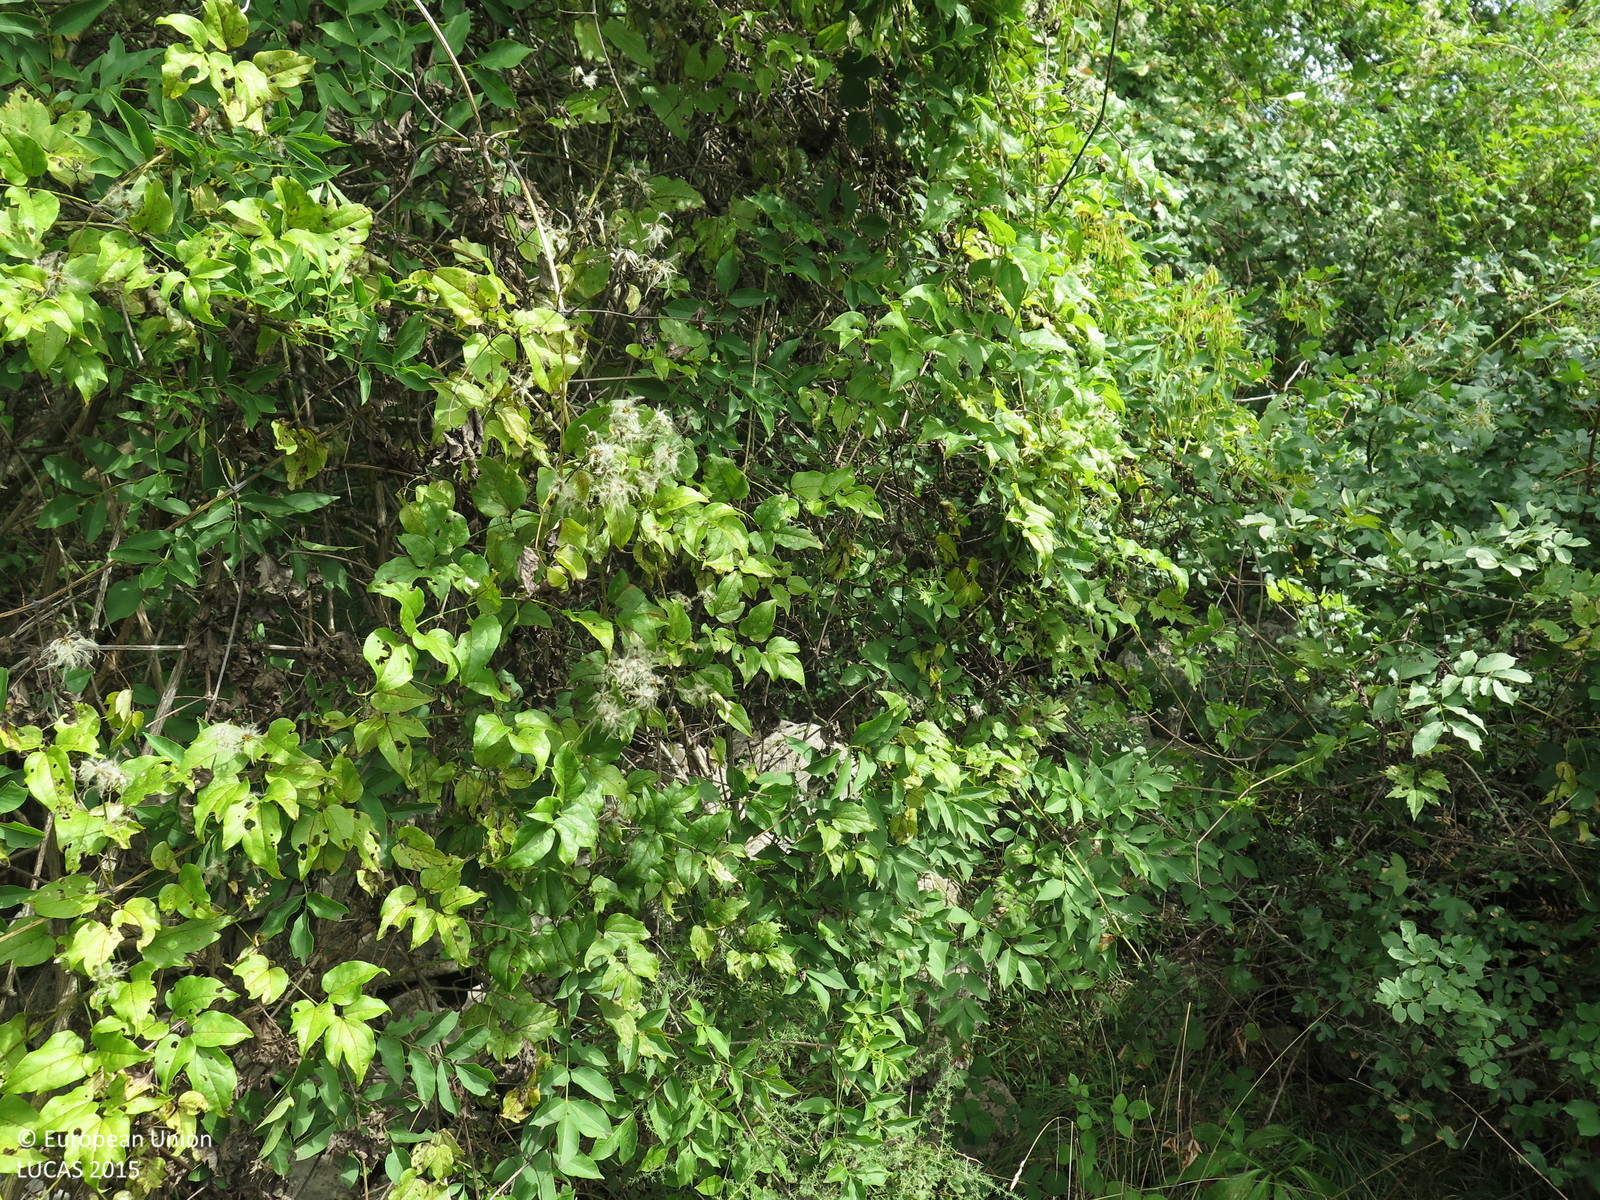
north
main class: Woodland
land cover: Broadleaved woodland
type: thermophilous deciduous forest
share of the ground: > 75 %
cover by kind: broadleaved forest trees 90 %, shrubs 5 %, herbaceous plants 5 %
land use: Semi-natural and natural areas not in use
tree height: > 5 m
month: August
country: HR
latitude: 45.1498
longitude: 14.6371
